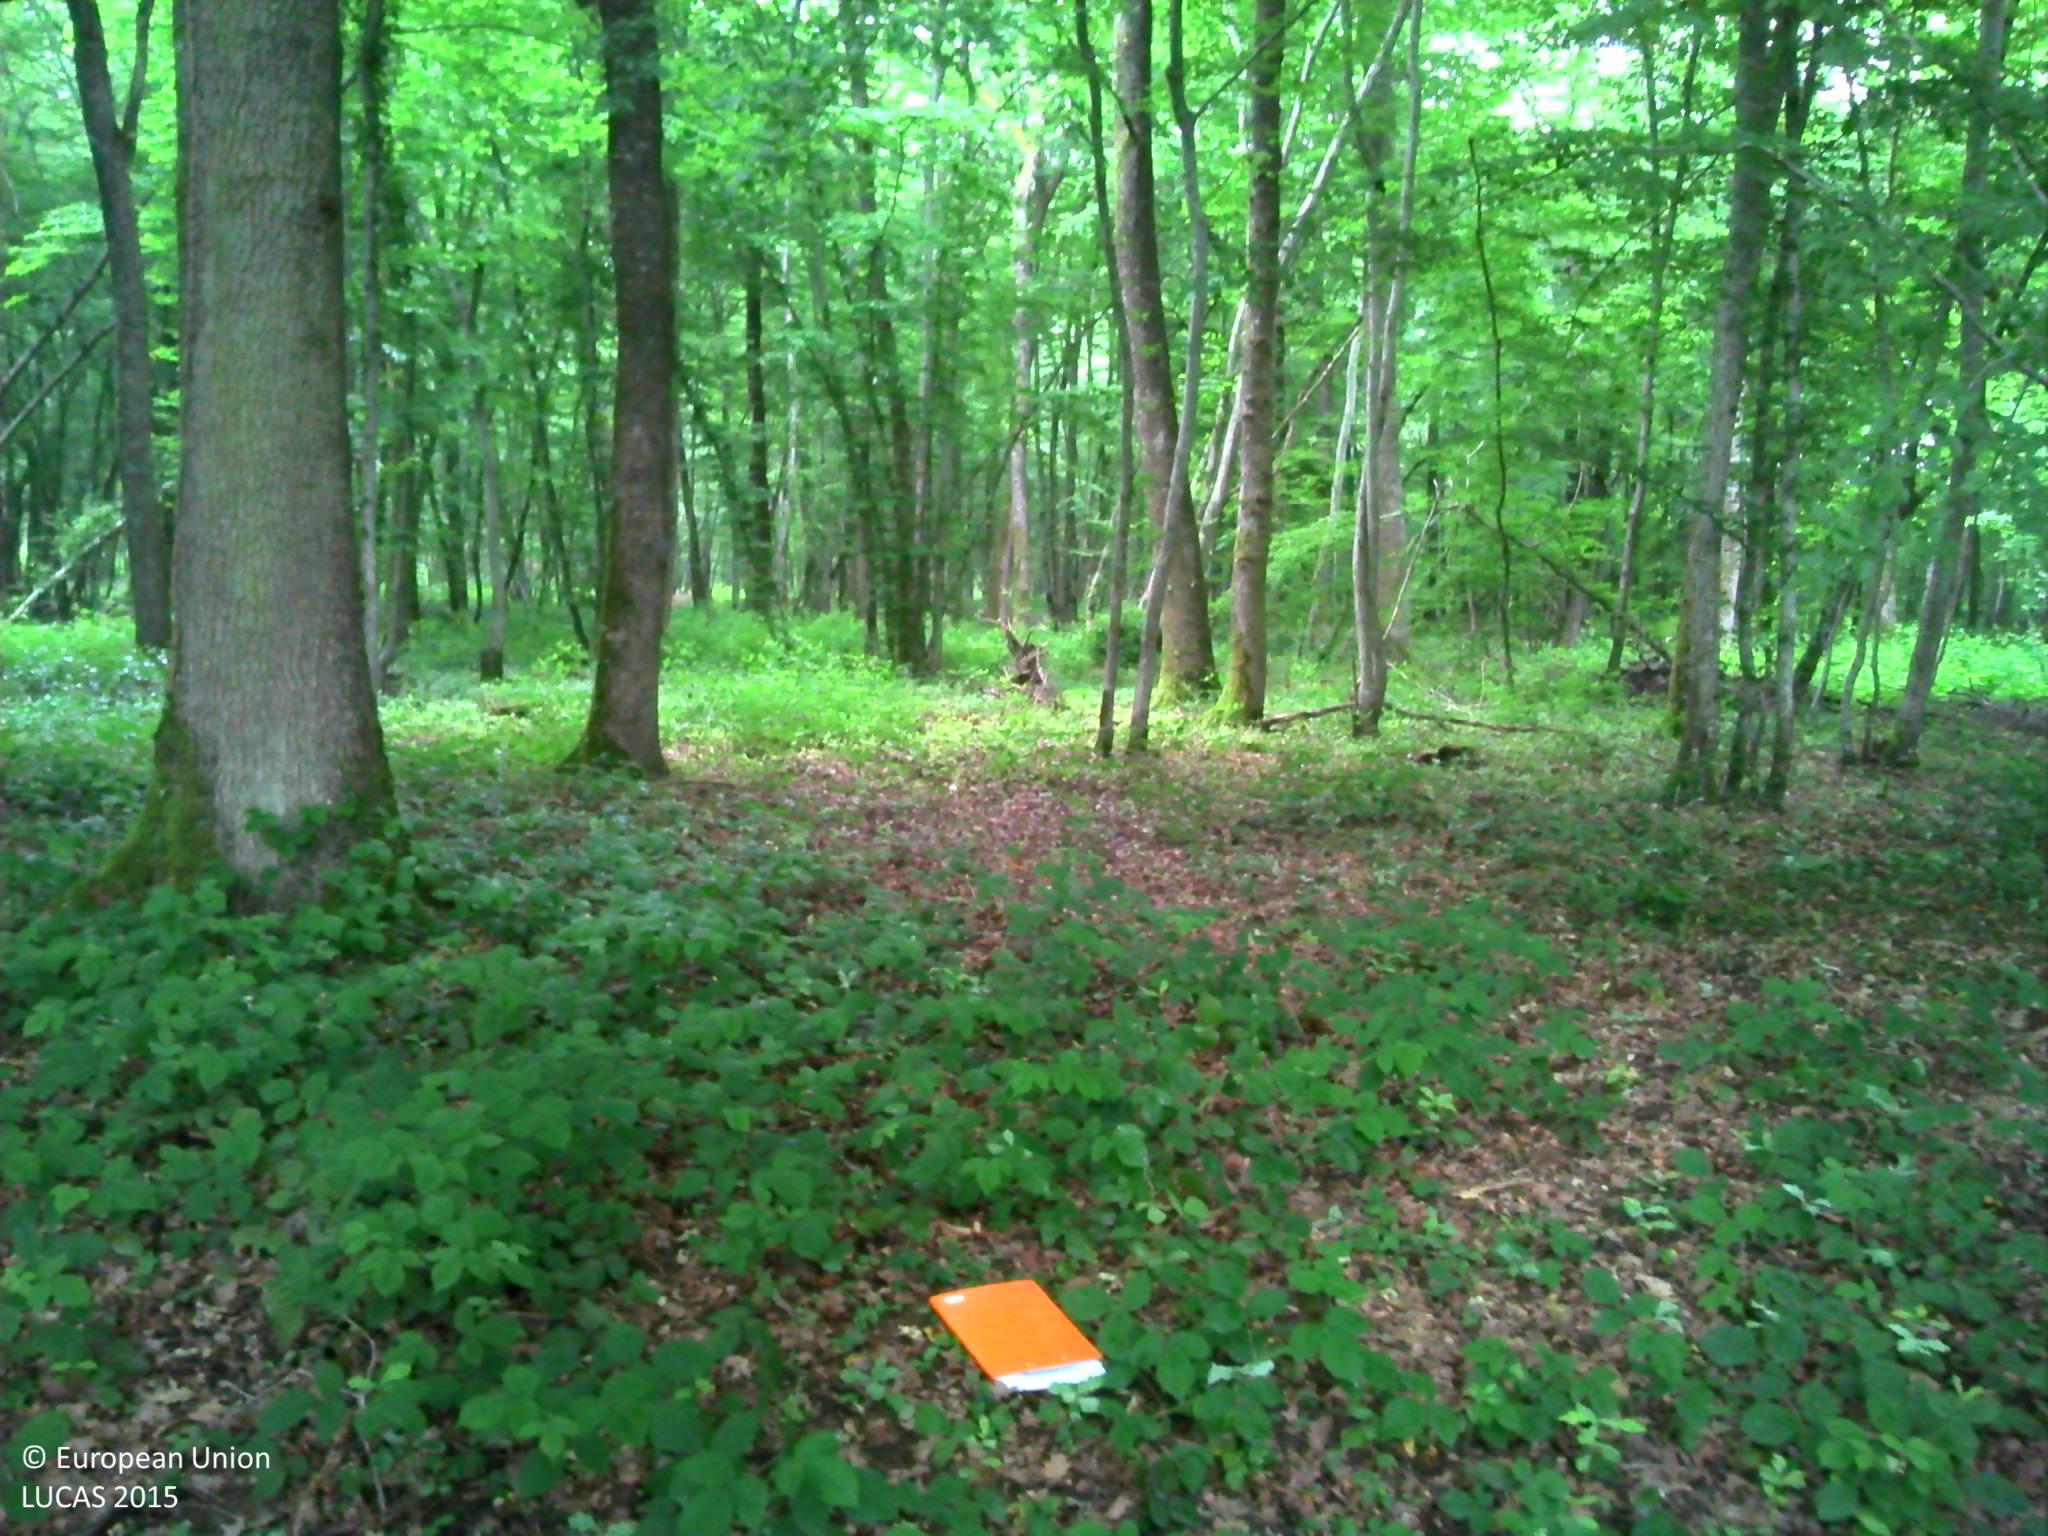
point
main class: Woodland
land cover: Broadleaved woodland
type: mesophytic deciduous forest
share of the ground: > 75 %
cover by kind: broadleaved forest trees 90 %, shrubs 5 %, herbaceous plants 5 %
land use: Forestry
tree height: > 5 m
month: June
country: FR
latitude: 46.3076
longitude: 3.0772
